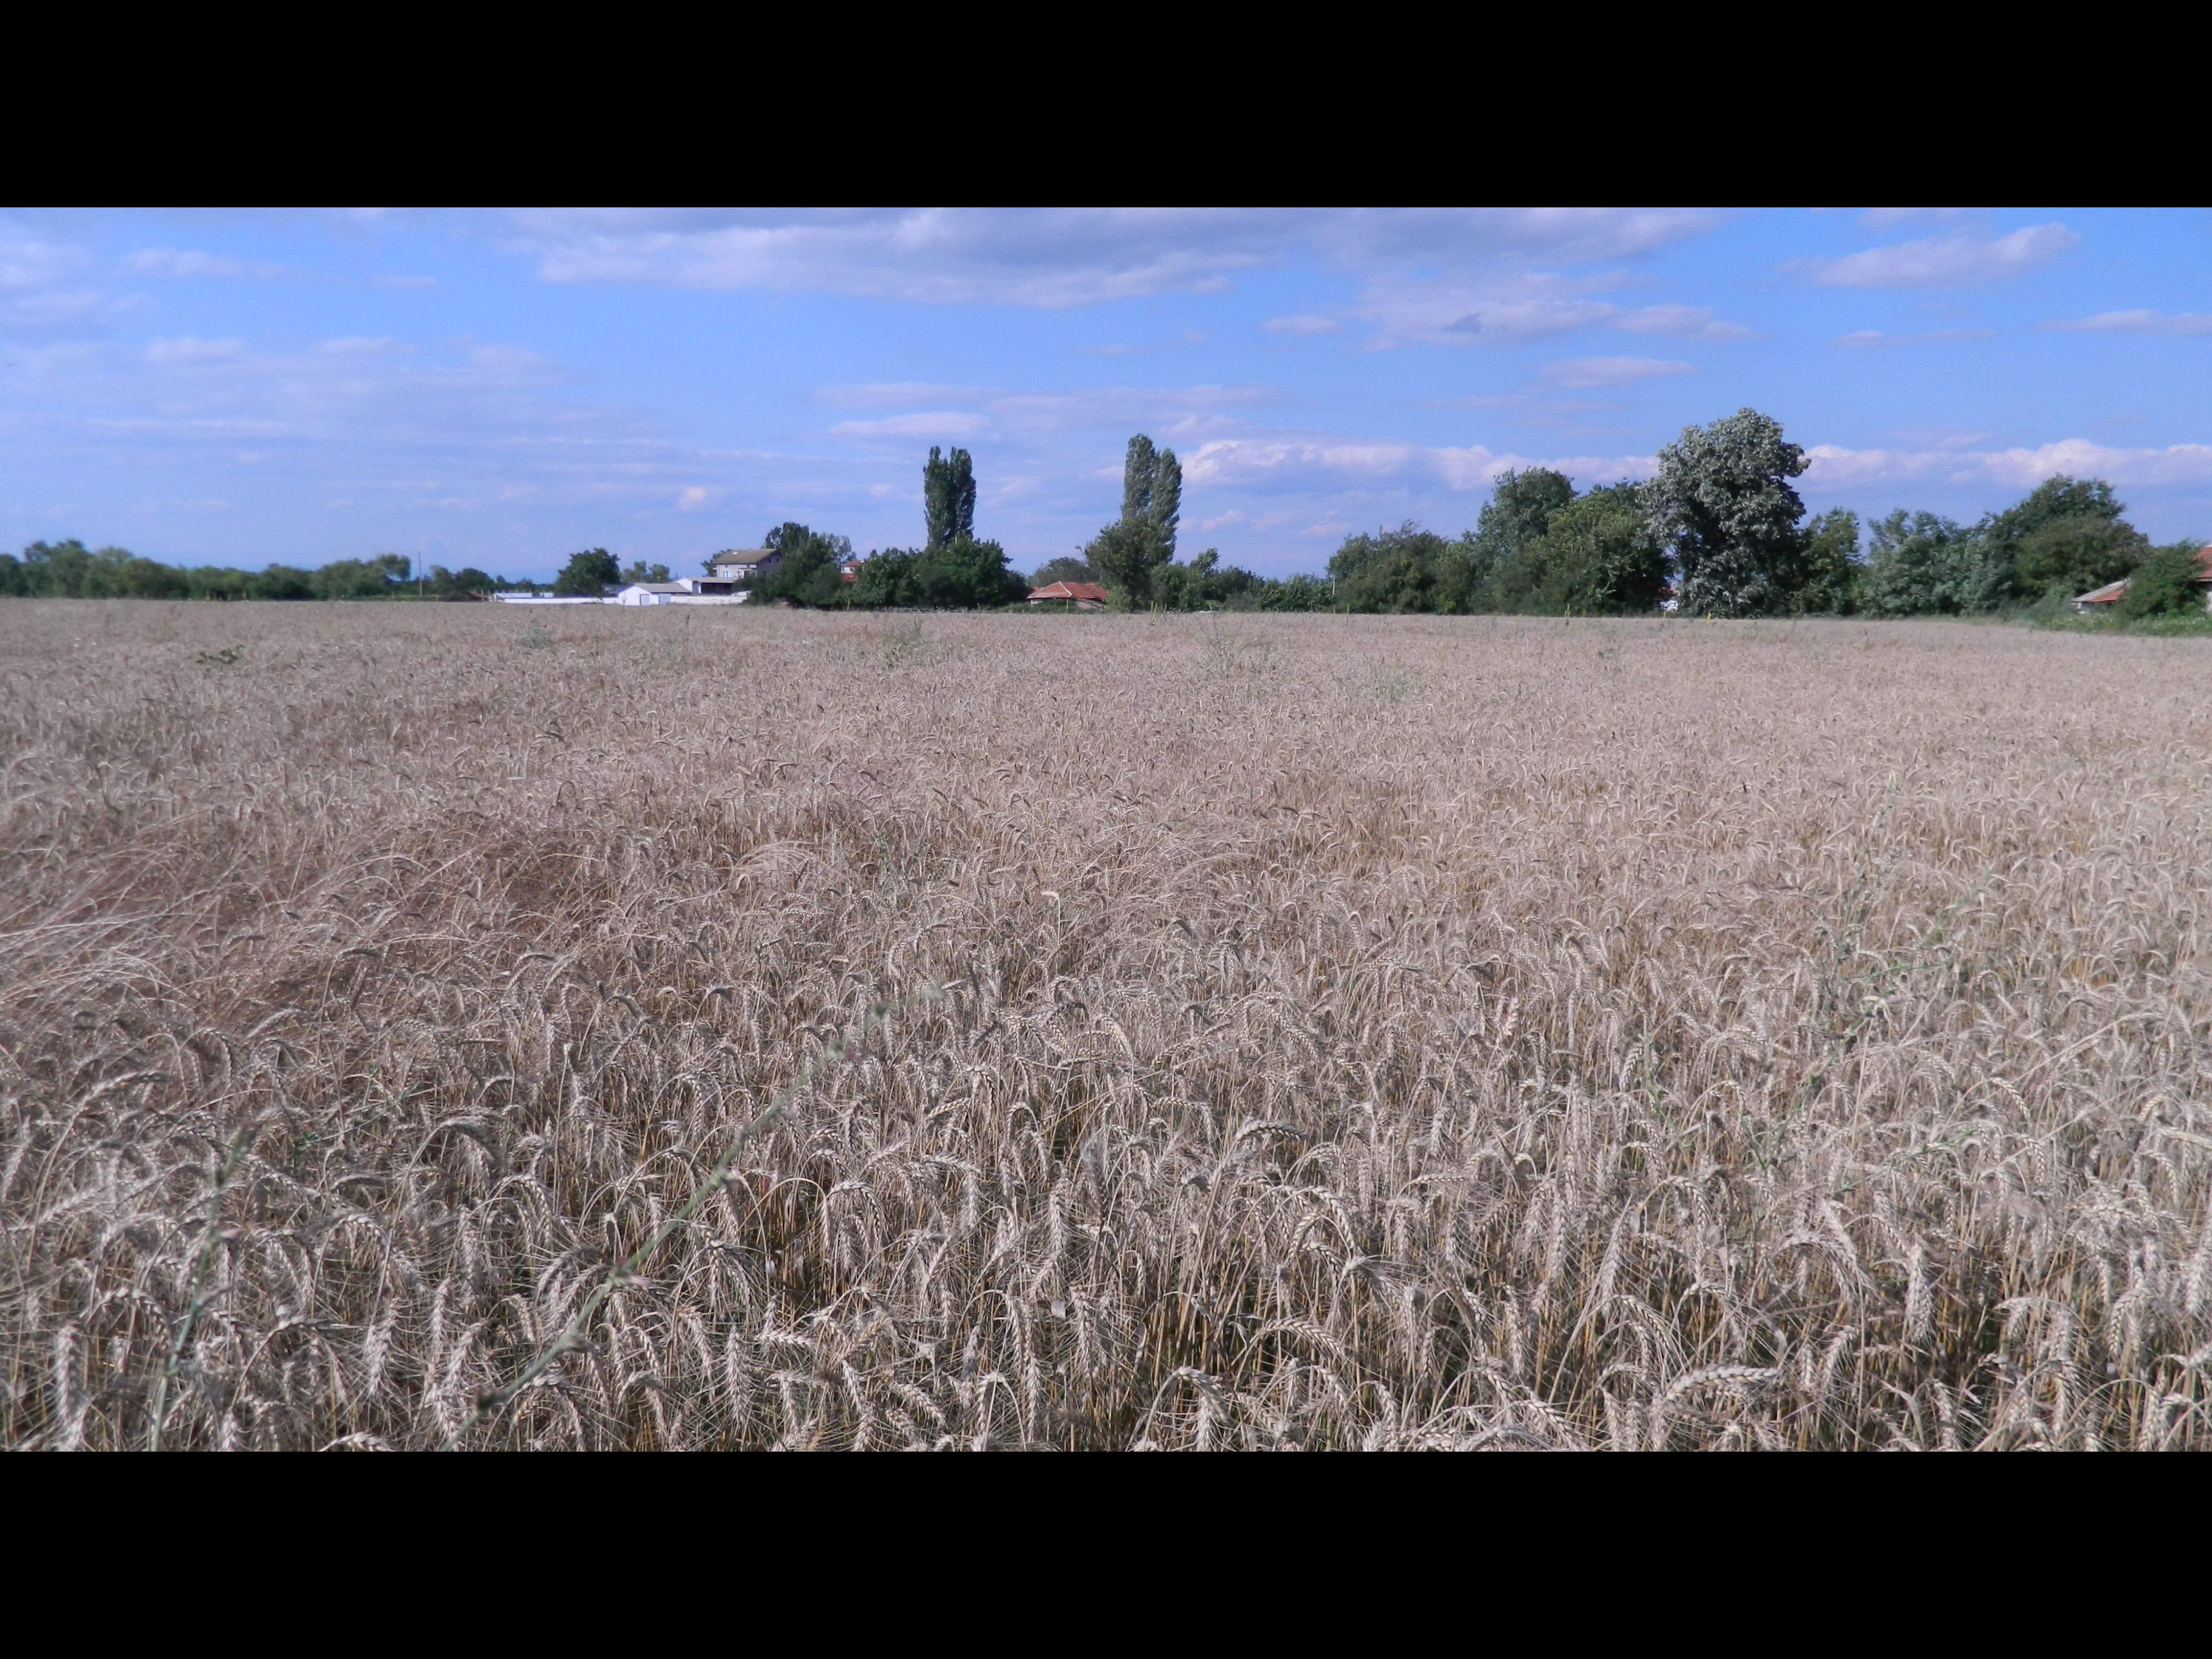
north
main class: Cropland
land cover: Common wheat
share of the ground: > 75 %
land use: Agriculture (excluding fallow land and kitchen gardens)
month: July
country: BG
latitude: 41.9406
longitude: 25.0716
